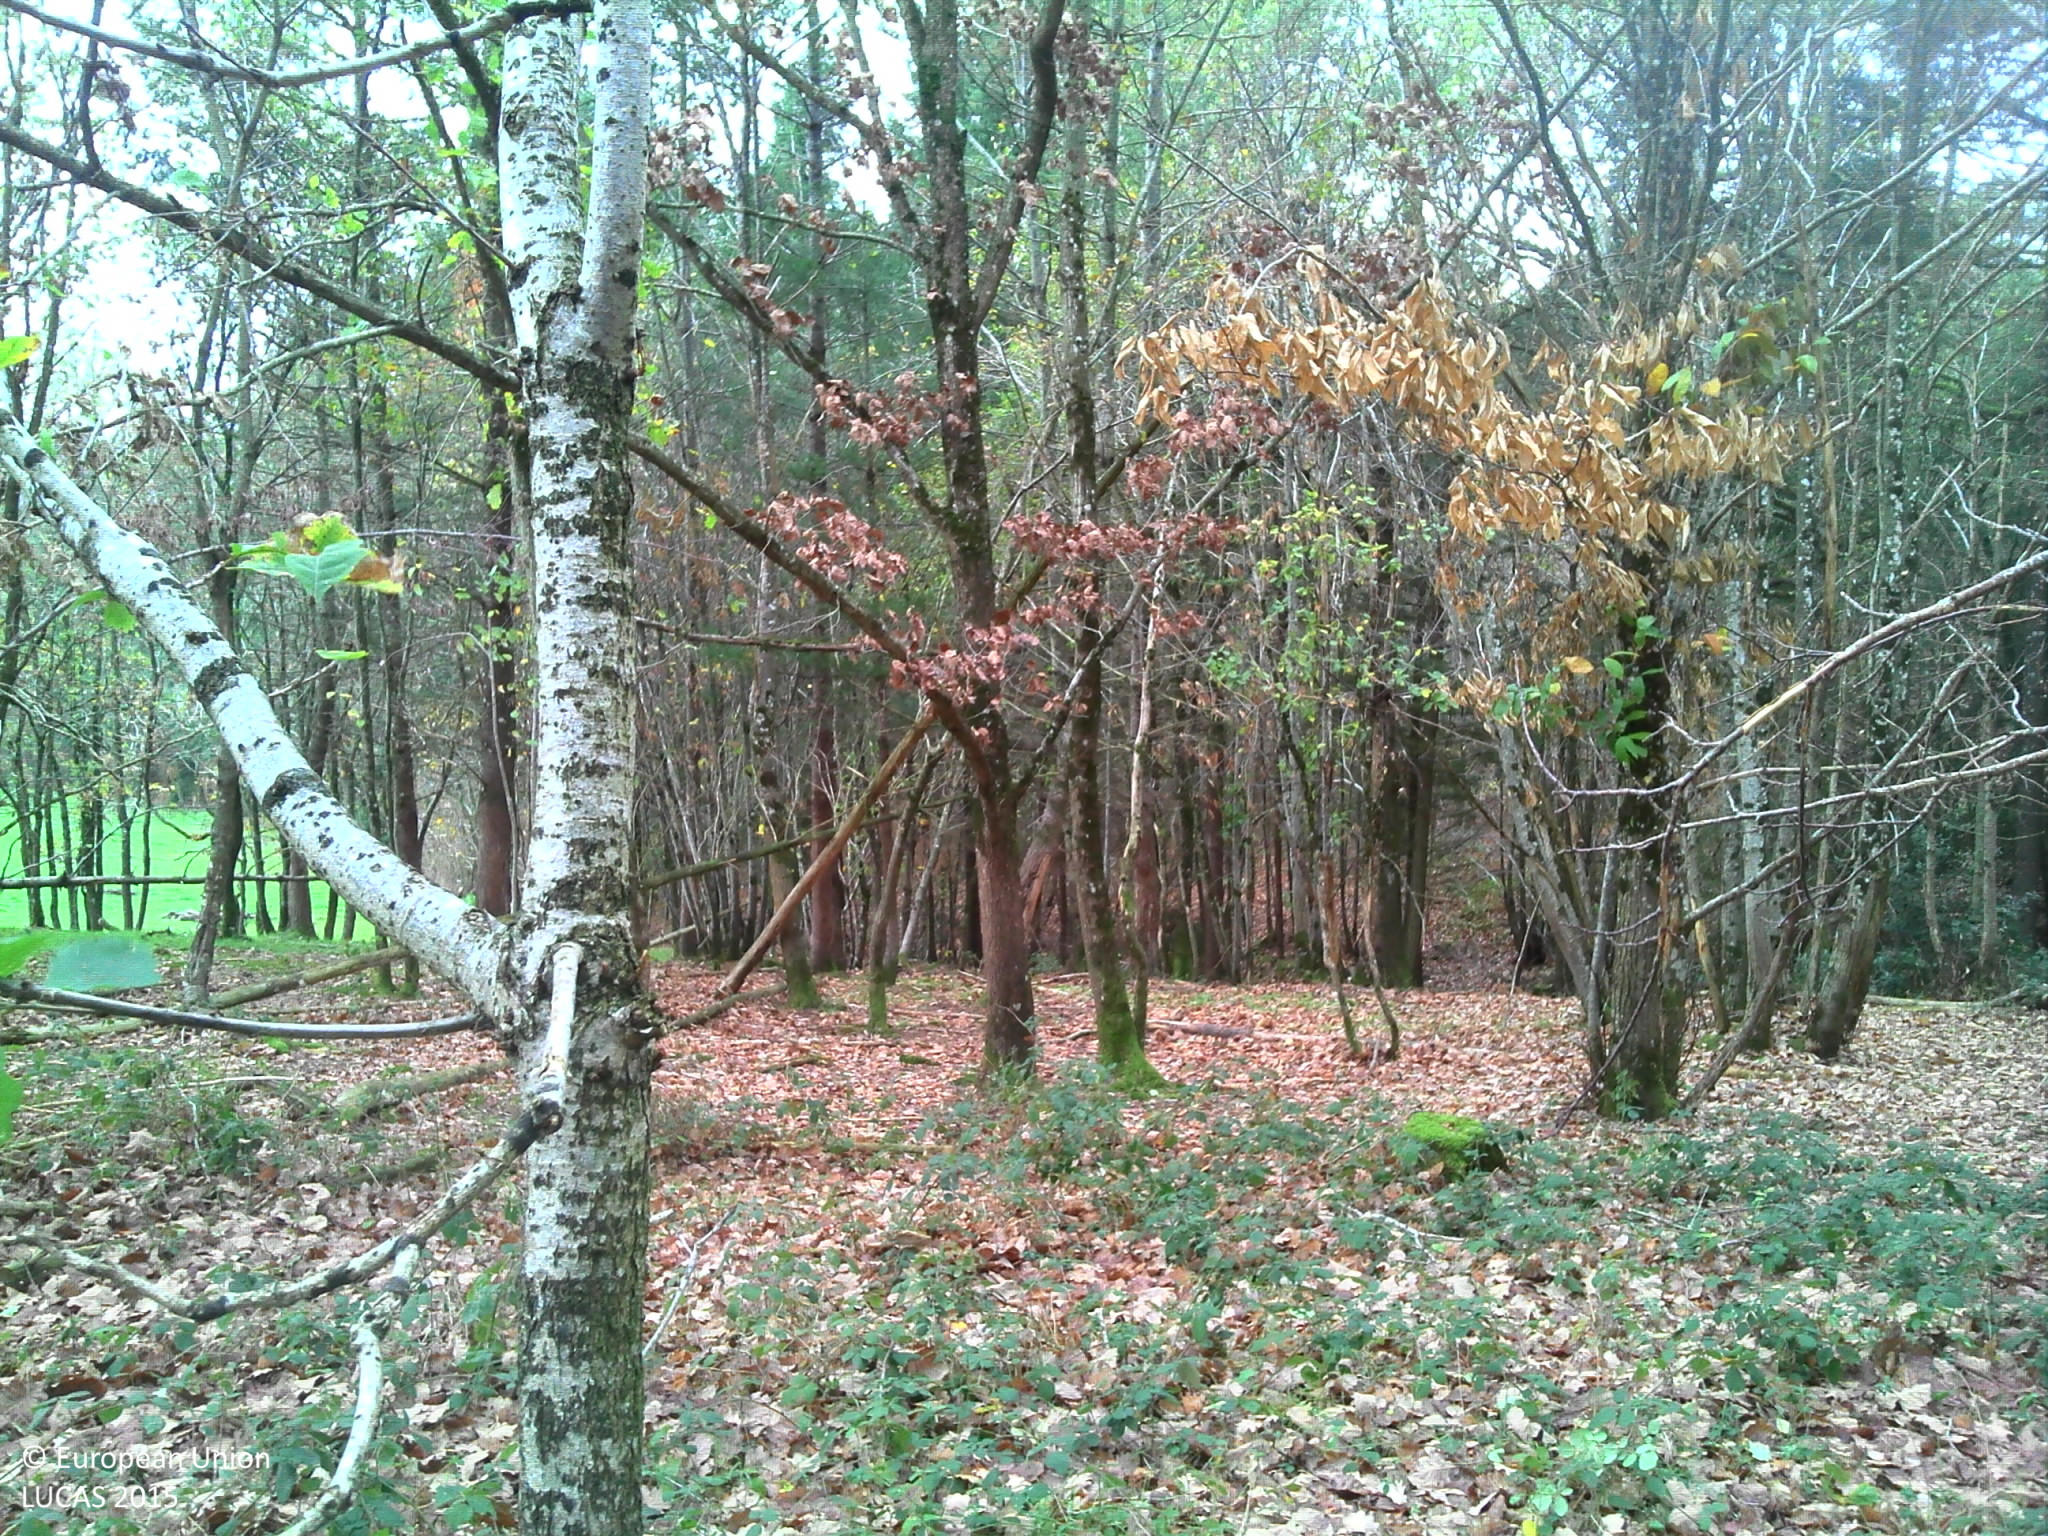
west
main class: Woodland
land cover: Broadleaved woodland
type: acidophilous oak and oak-birch forest
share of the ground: 50 - 75 %
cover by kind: broadleaved forest trees 70 %, shrubs 10 %, herbaceous plants 10 %, consolidated bare surface 10 %
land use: Forestry
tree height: > 5 m
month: November
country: FR
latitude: 46.2906
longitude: 3.6784
